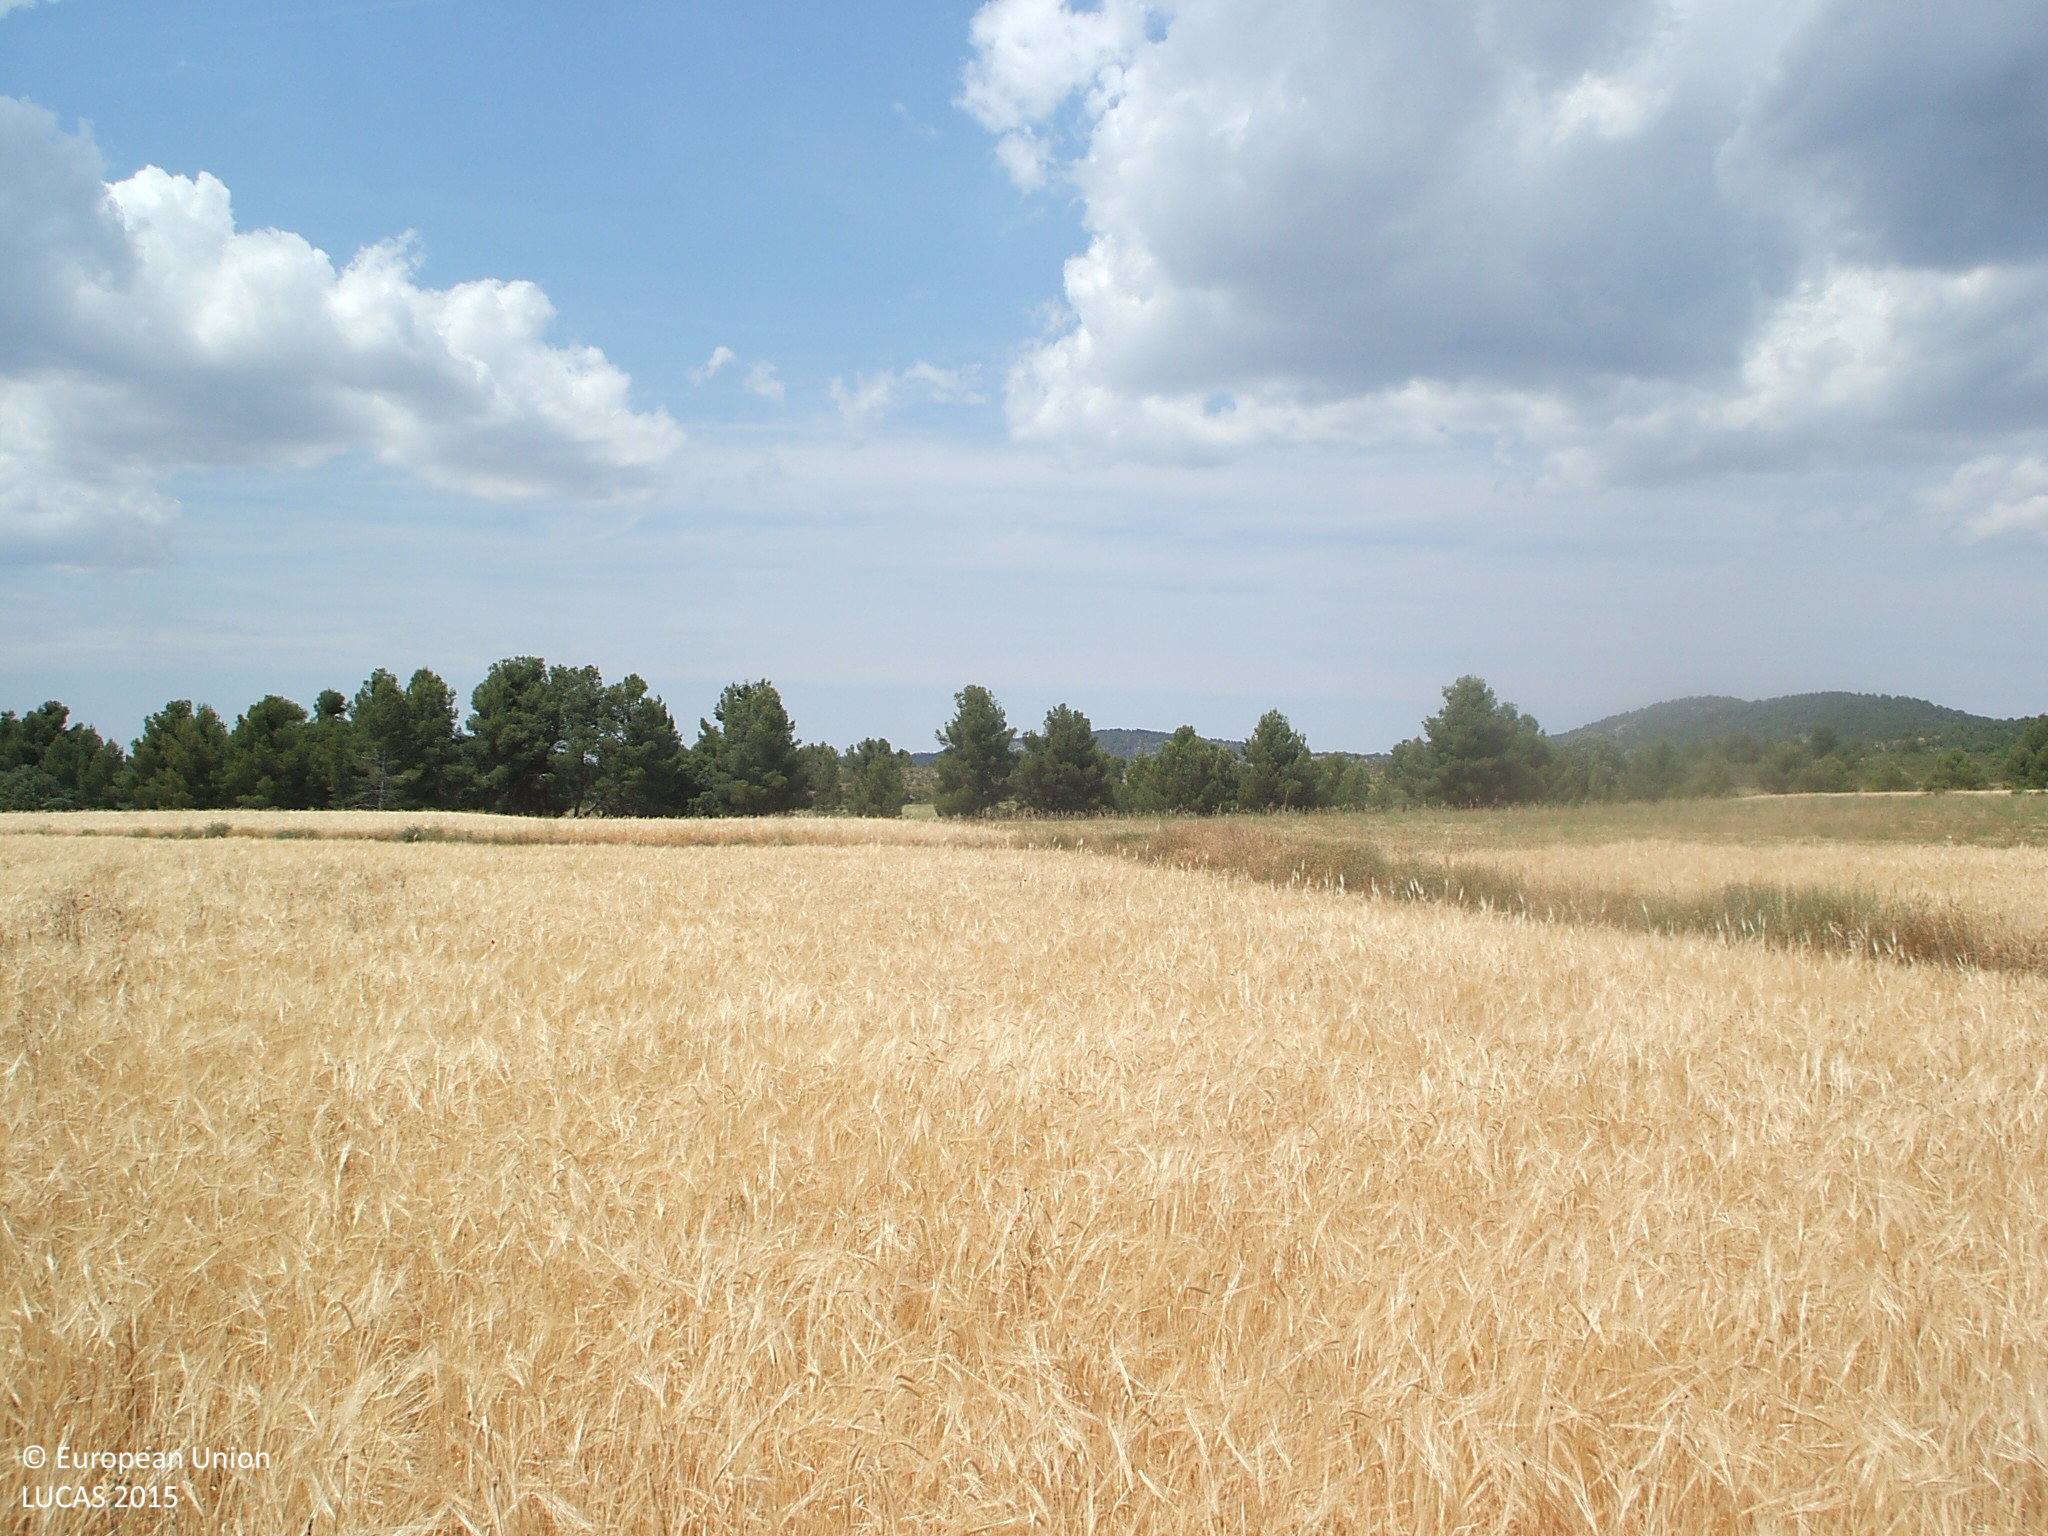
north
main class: Cropland
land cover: Barley
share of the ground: > 75 %
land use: Agriculture (excluding fallow land and kitchen gardens)
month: June
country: ES
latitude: 40.8148
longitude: -0.1457
